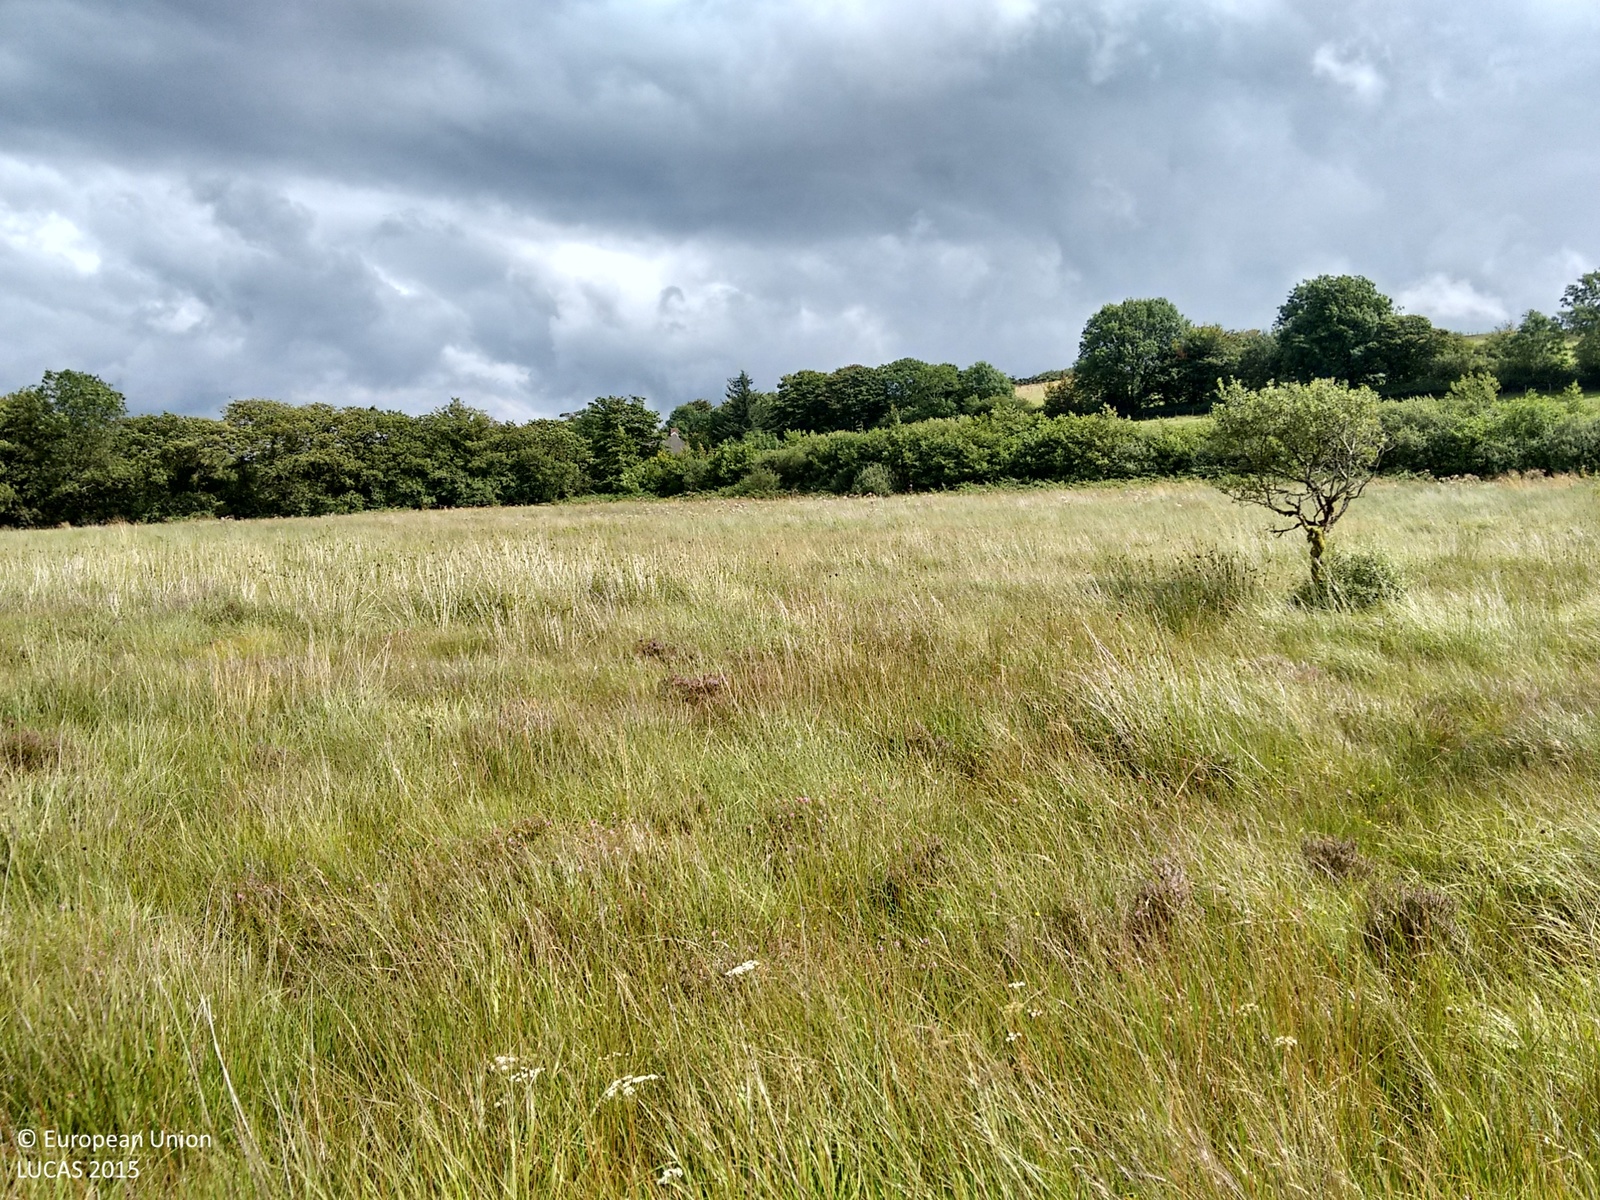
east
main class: Grassland
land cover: Grassland without tree/shrub cover
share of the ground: > 75 %
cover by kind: herbaceous plants 100 %
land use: Agriculture (excluding fallow land and kitchen gardens)
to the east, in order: Grassland without tree/shrub cover; Fences; Managed hedges; Fences; Grassland without tree/shrub cover; Managed hedges; Grassland without tree/shrub cover; Fences; Abandoned hedges; Fences; Tracks; Lines of trees; Tracks; Grassland without tree/shrub cover
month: August
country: GB
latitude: 51.9527
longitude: -4.0793
